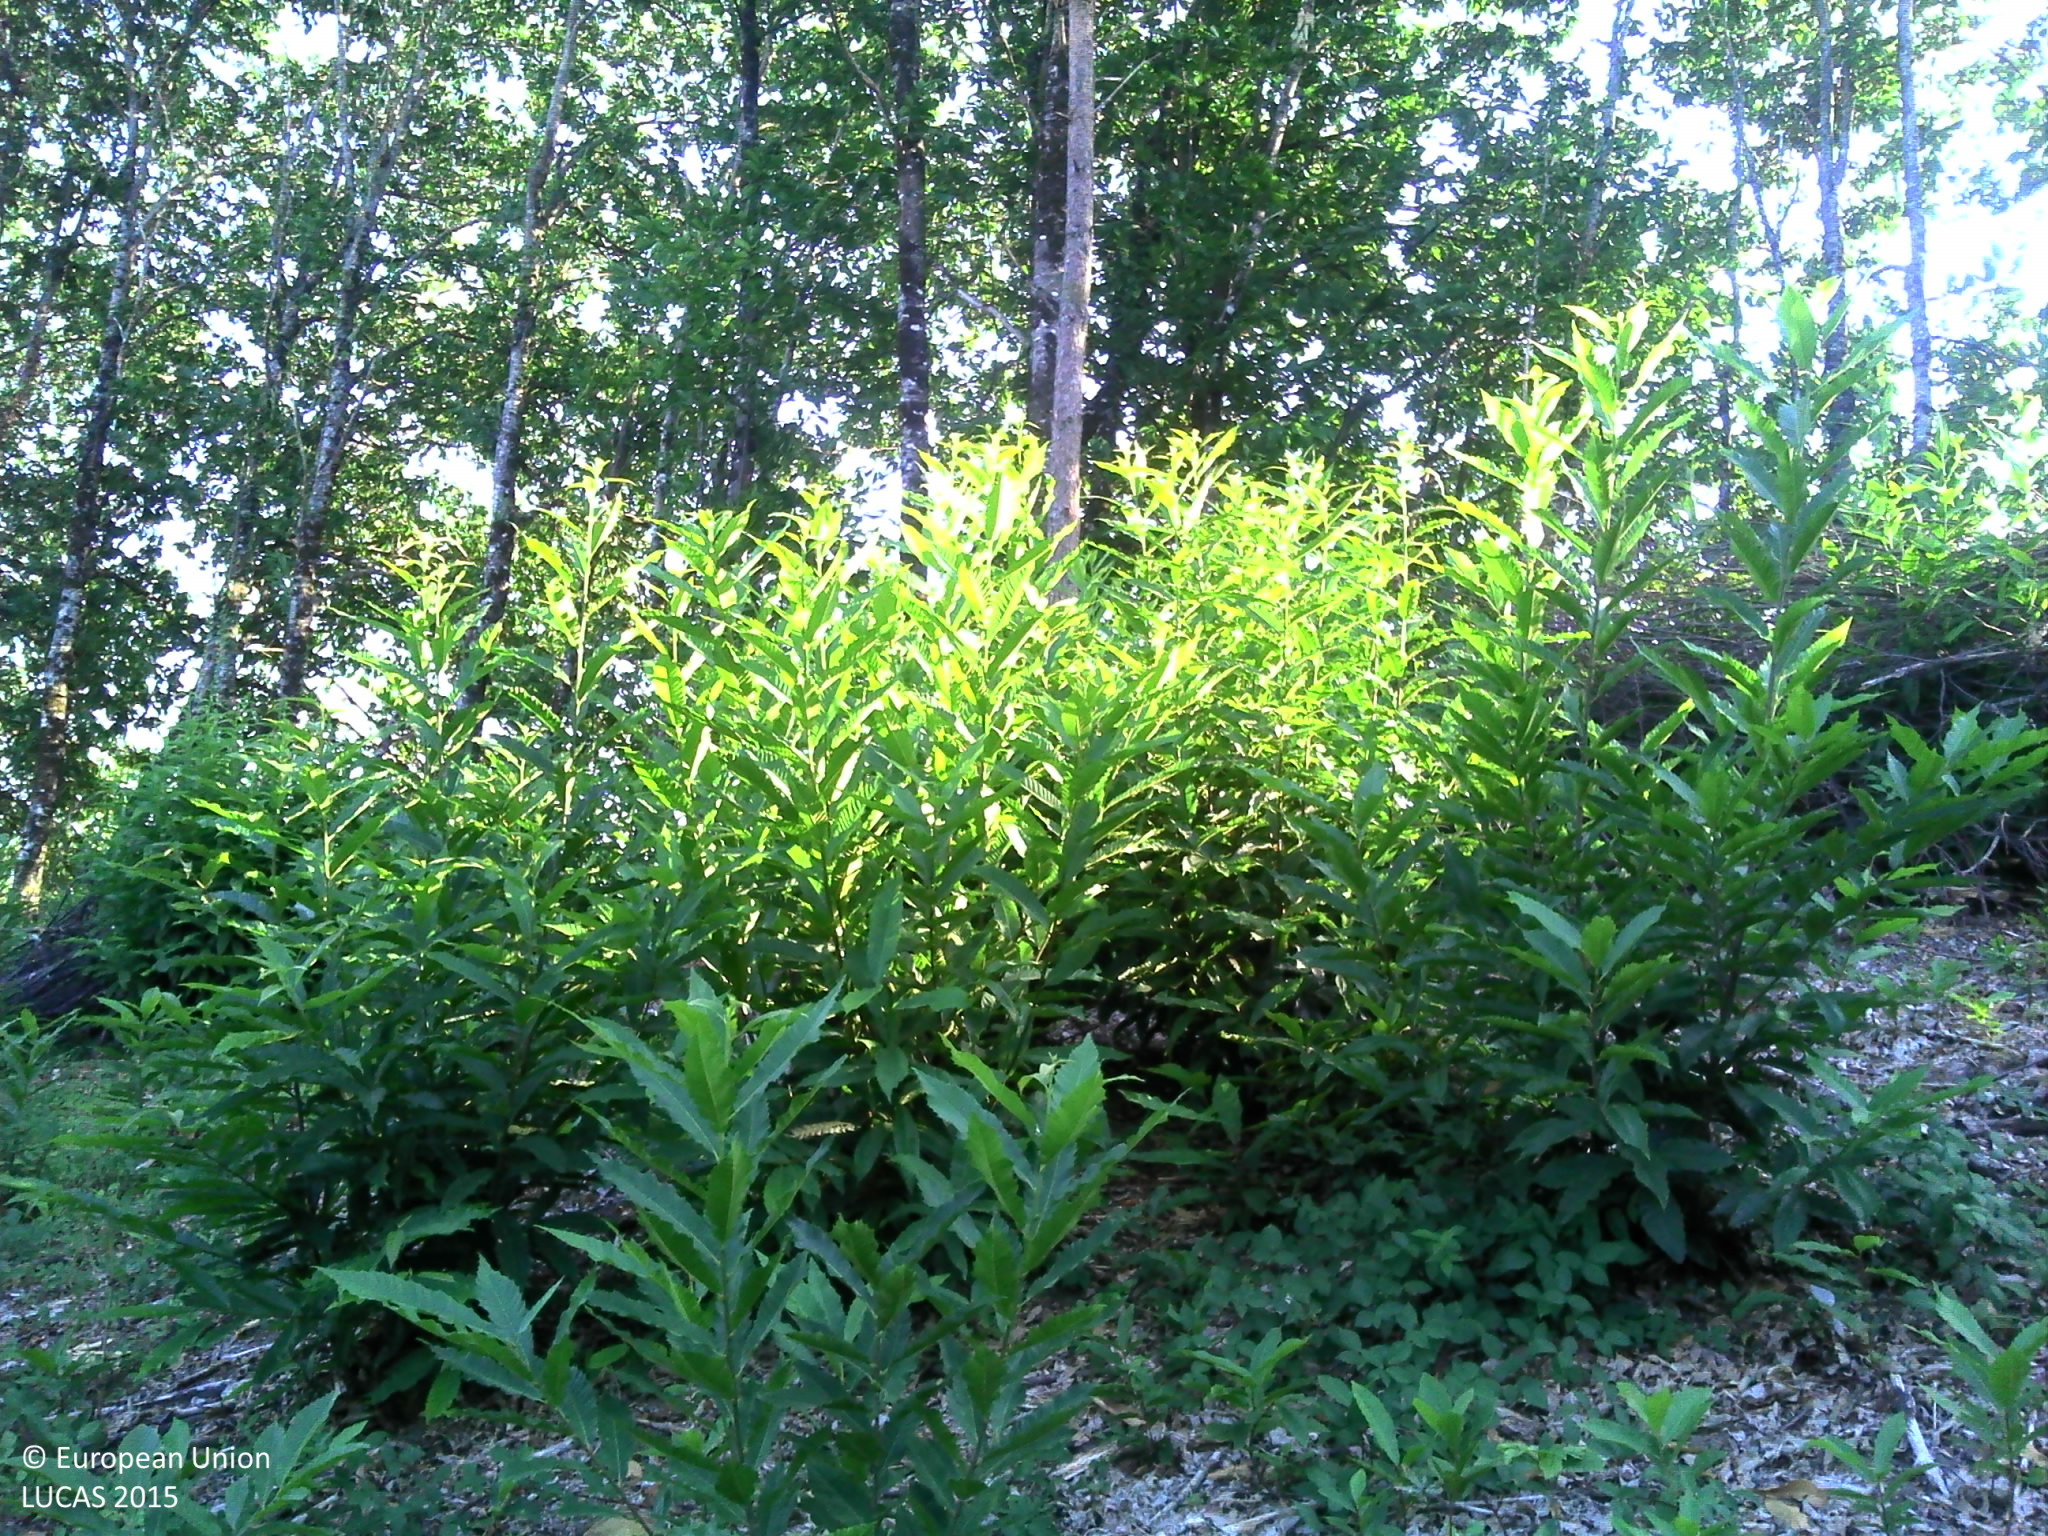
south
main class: Woodland
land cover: Broadleaved woodland
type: thermophilous deciduous forest
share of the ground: 50 - 75 %
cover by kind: broadleaved forest trees 50 %, unconsolidated bare surface 50 %
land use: Forestry
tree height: > 5 m
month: August
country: FR
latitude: 45.3034
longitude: 1.6931
